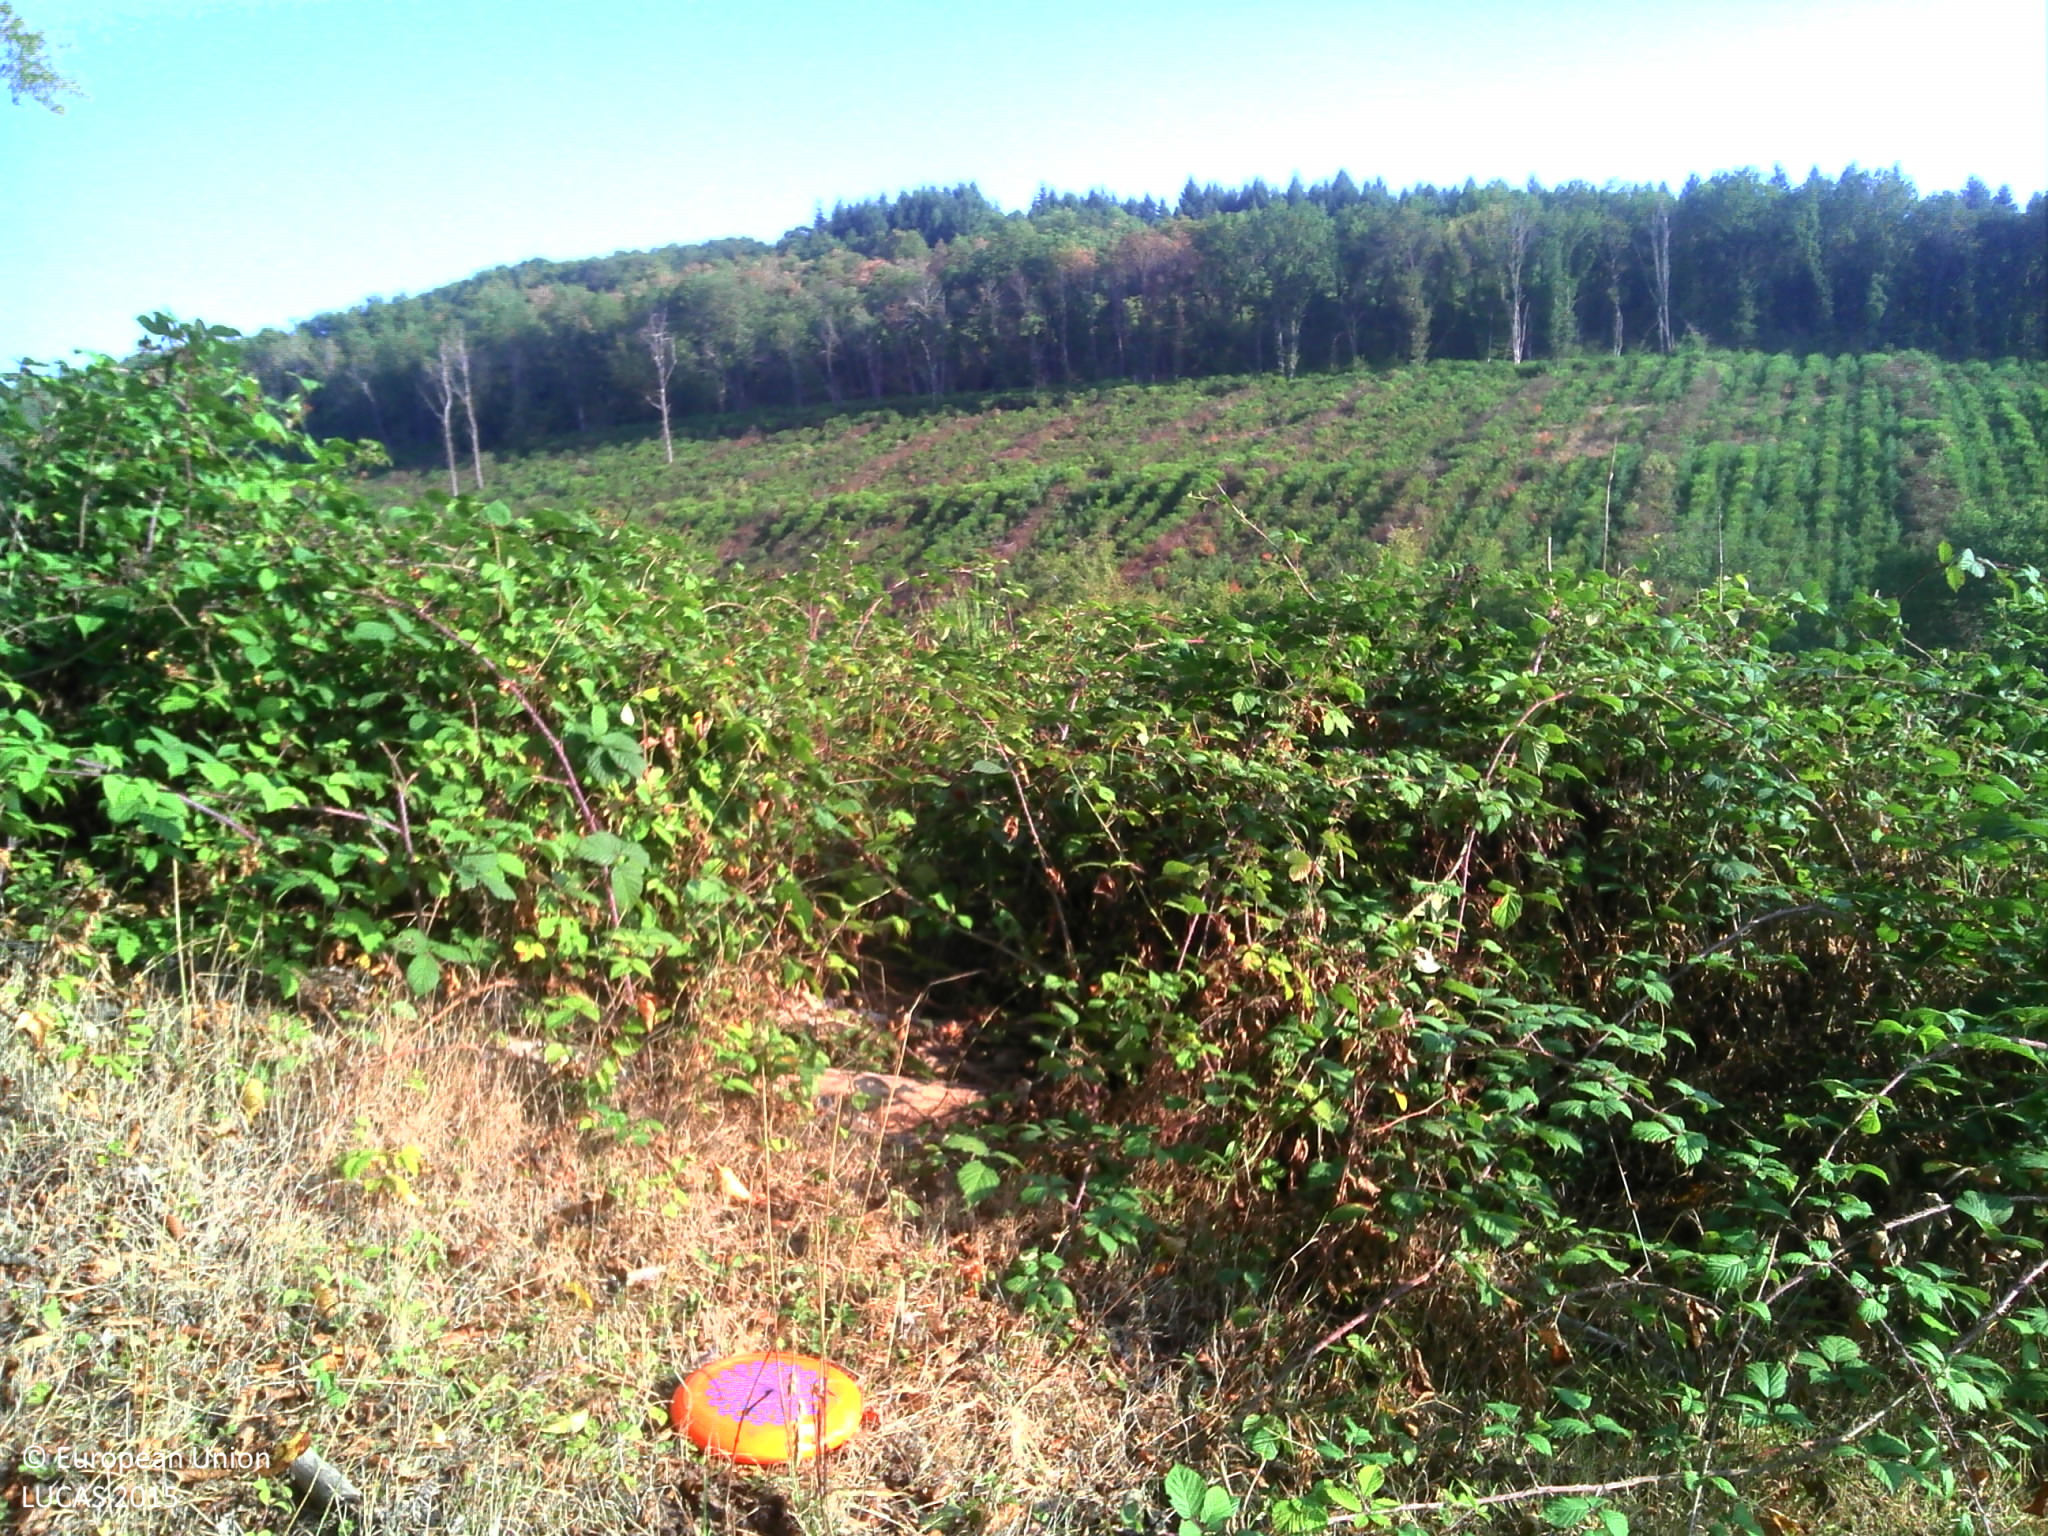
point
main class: Shrubland
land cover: Shrubland without tree cover
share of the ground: > 75 %
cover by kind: shrubs 50 %, herbaceous plants 50 %
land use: Forestry
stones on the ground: < 10 %
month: August
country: FR
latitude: 47.1028
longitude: 4.3205
